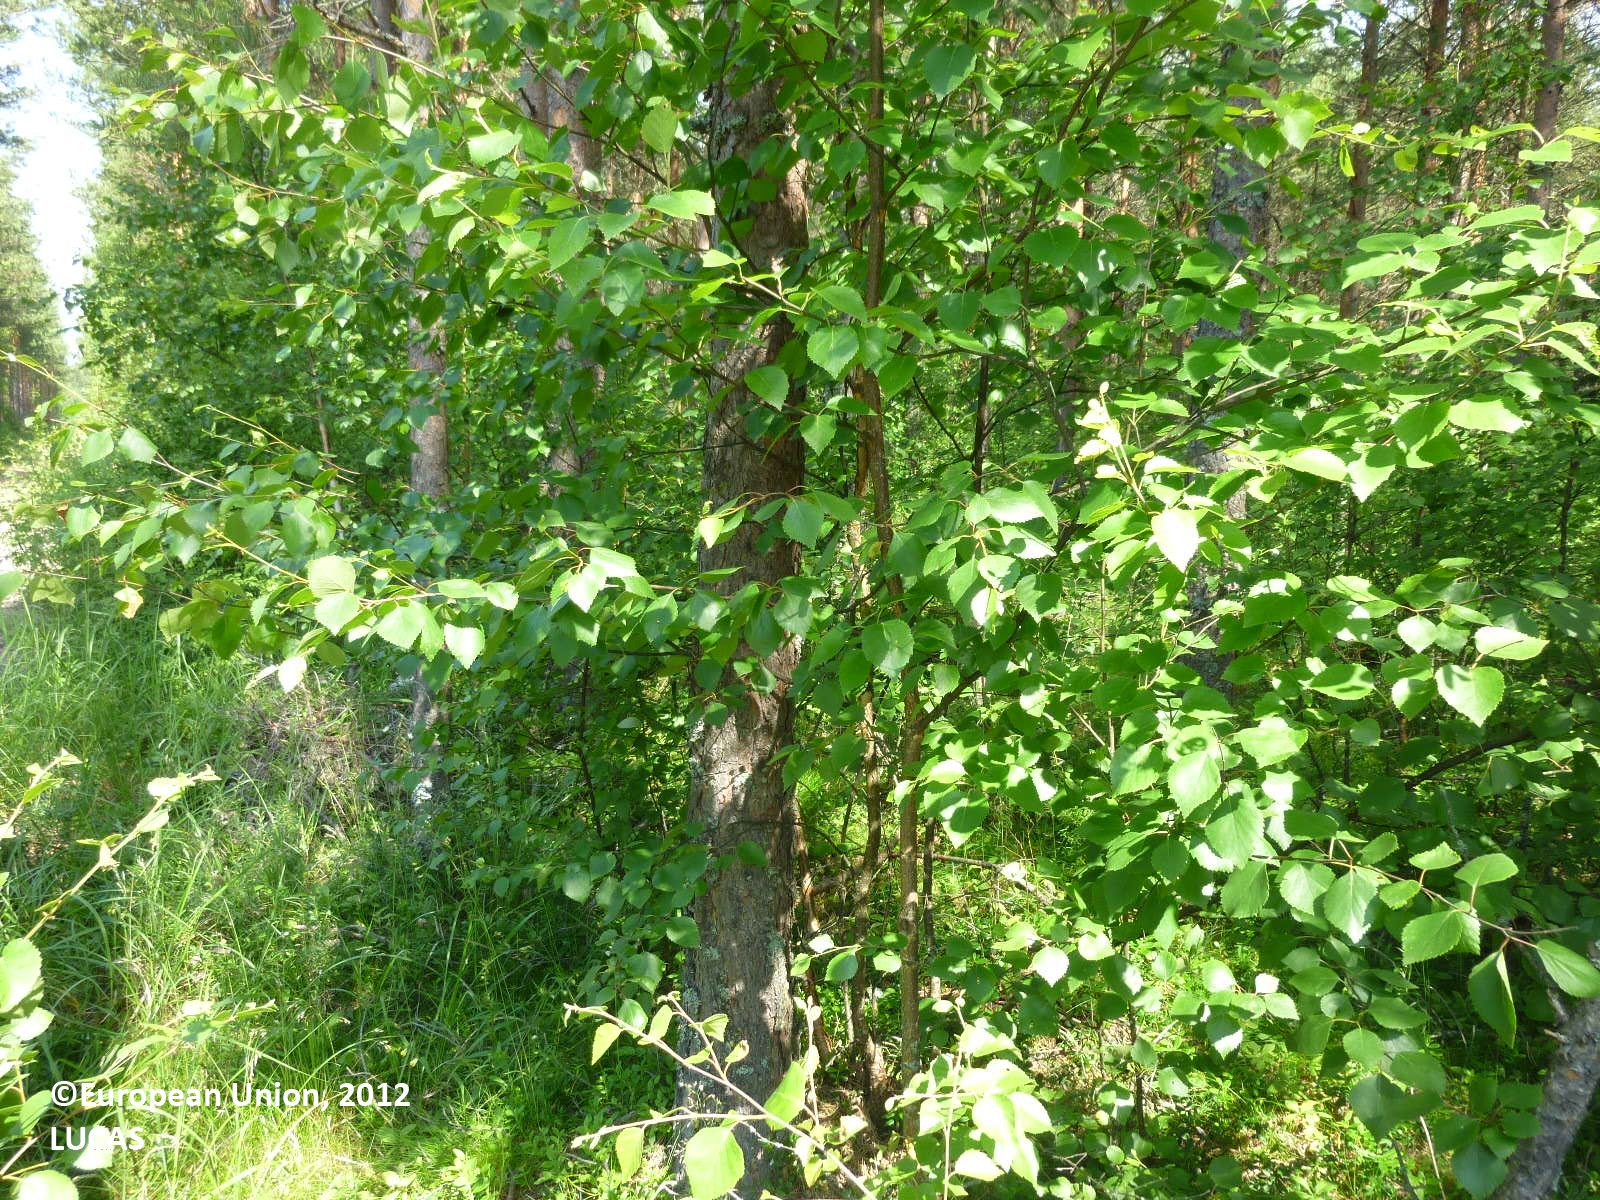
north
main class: Artificial land
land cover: Non built-up linear features
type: boreal forest
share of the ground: > 75 %
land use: Road transport
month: July
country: FI
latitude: 61.2337
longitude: 22.4521
